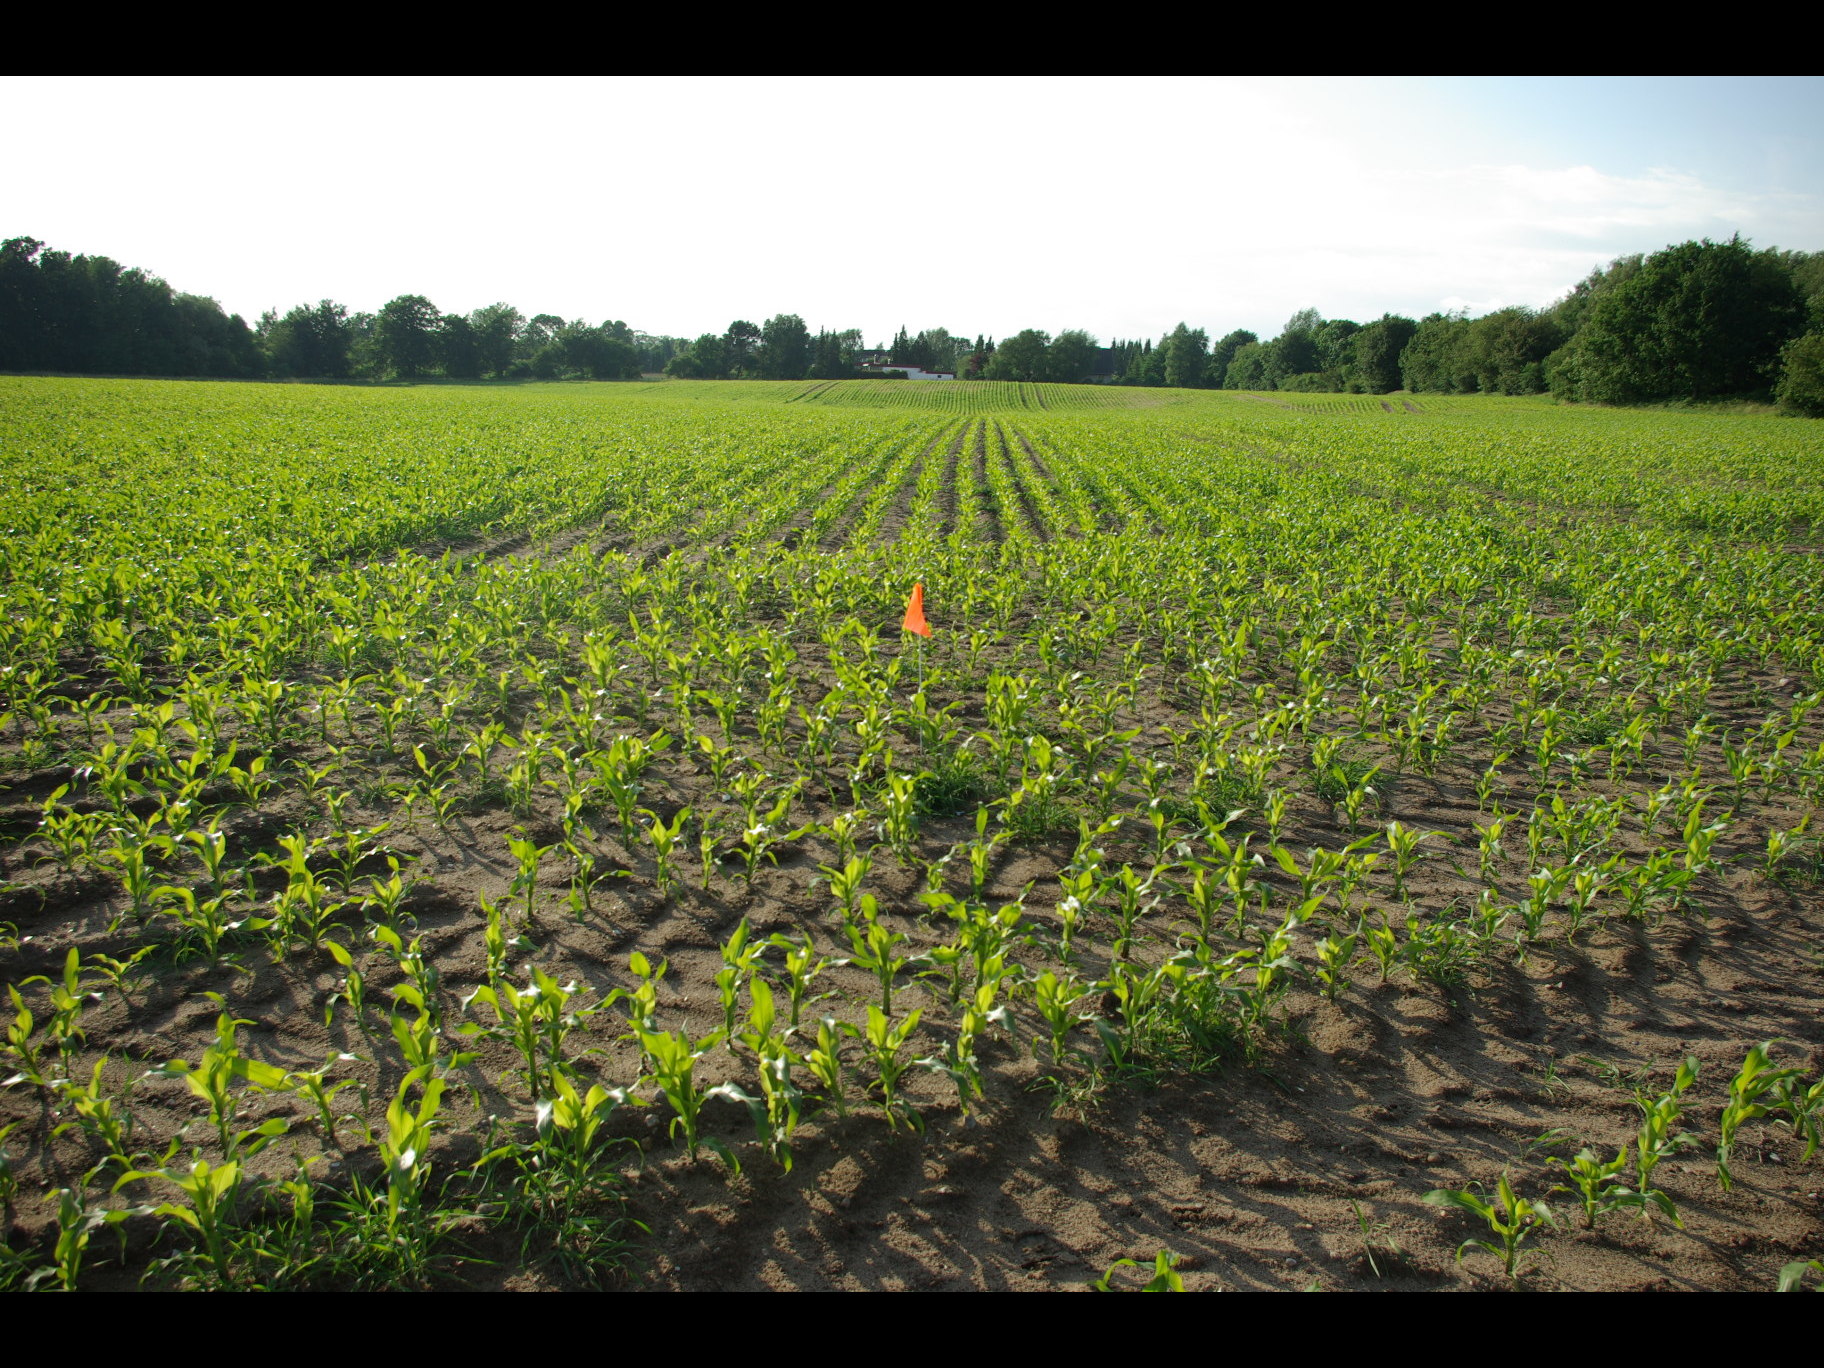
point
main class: Cropland
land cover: Maize
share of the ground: 25 - 50 %
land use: Agriculture (excluding fallow land and kitchen gardens)
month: June
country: DE
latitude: 54.2106
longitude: 9.8927
